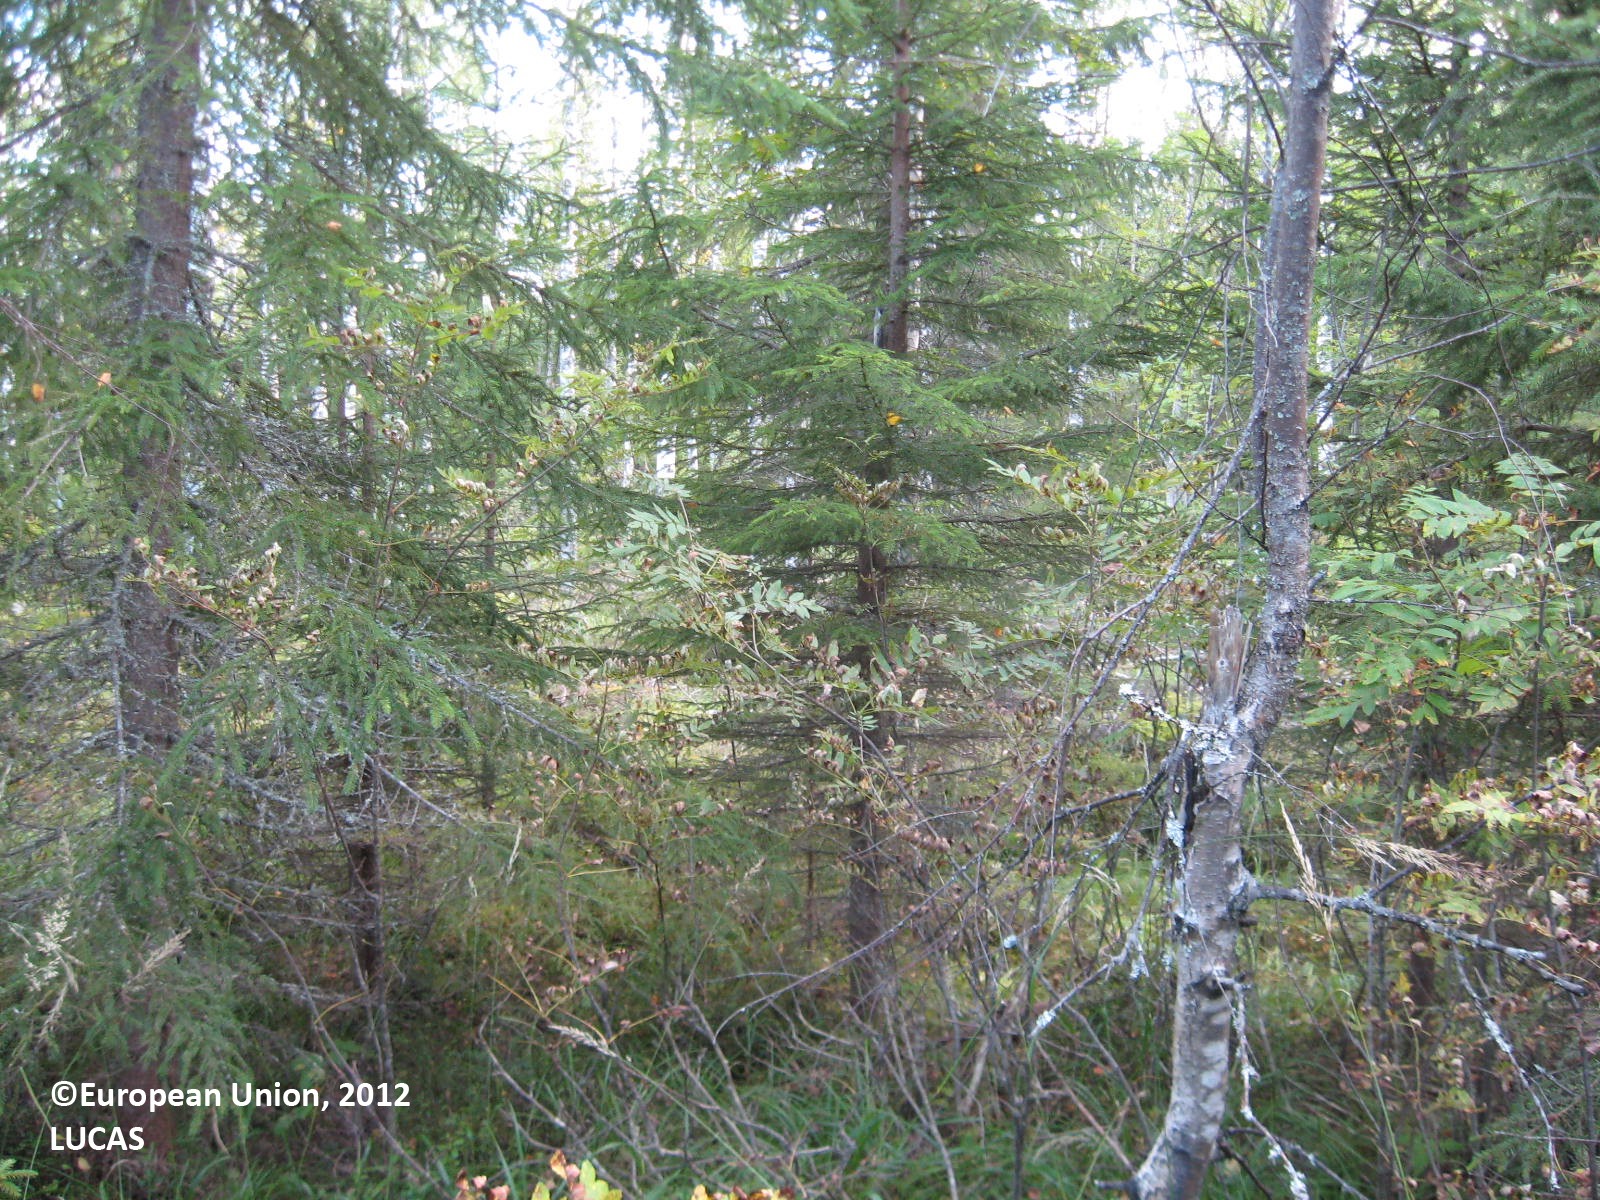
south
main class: Woodland
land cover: Other mixed woodland
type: boreal forest
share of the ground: > 75 %
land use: Forestry
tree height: > 5 m
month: August
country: FI
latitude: 63.5959
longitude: 29.8095
